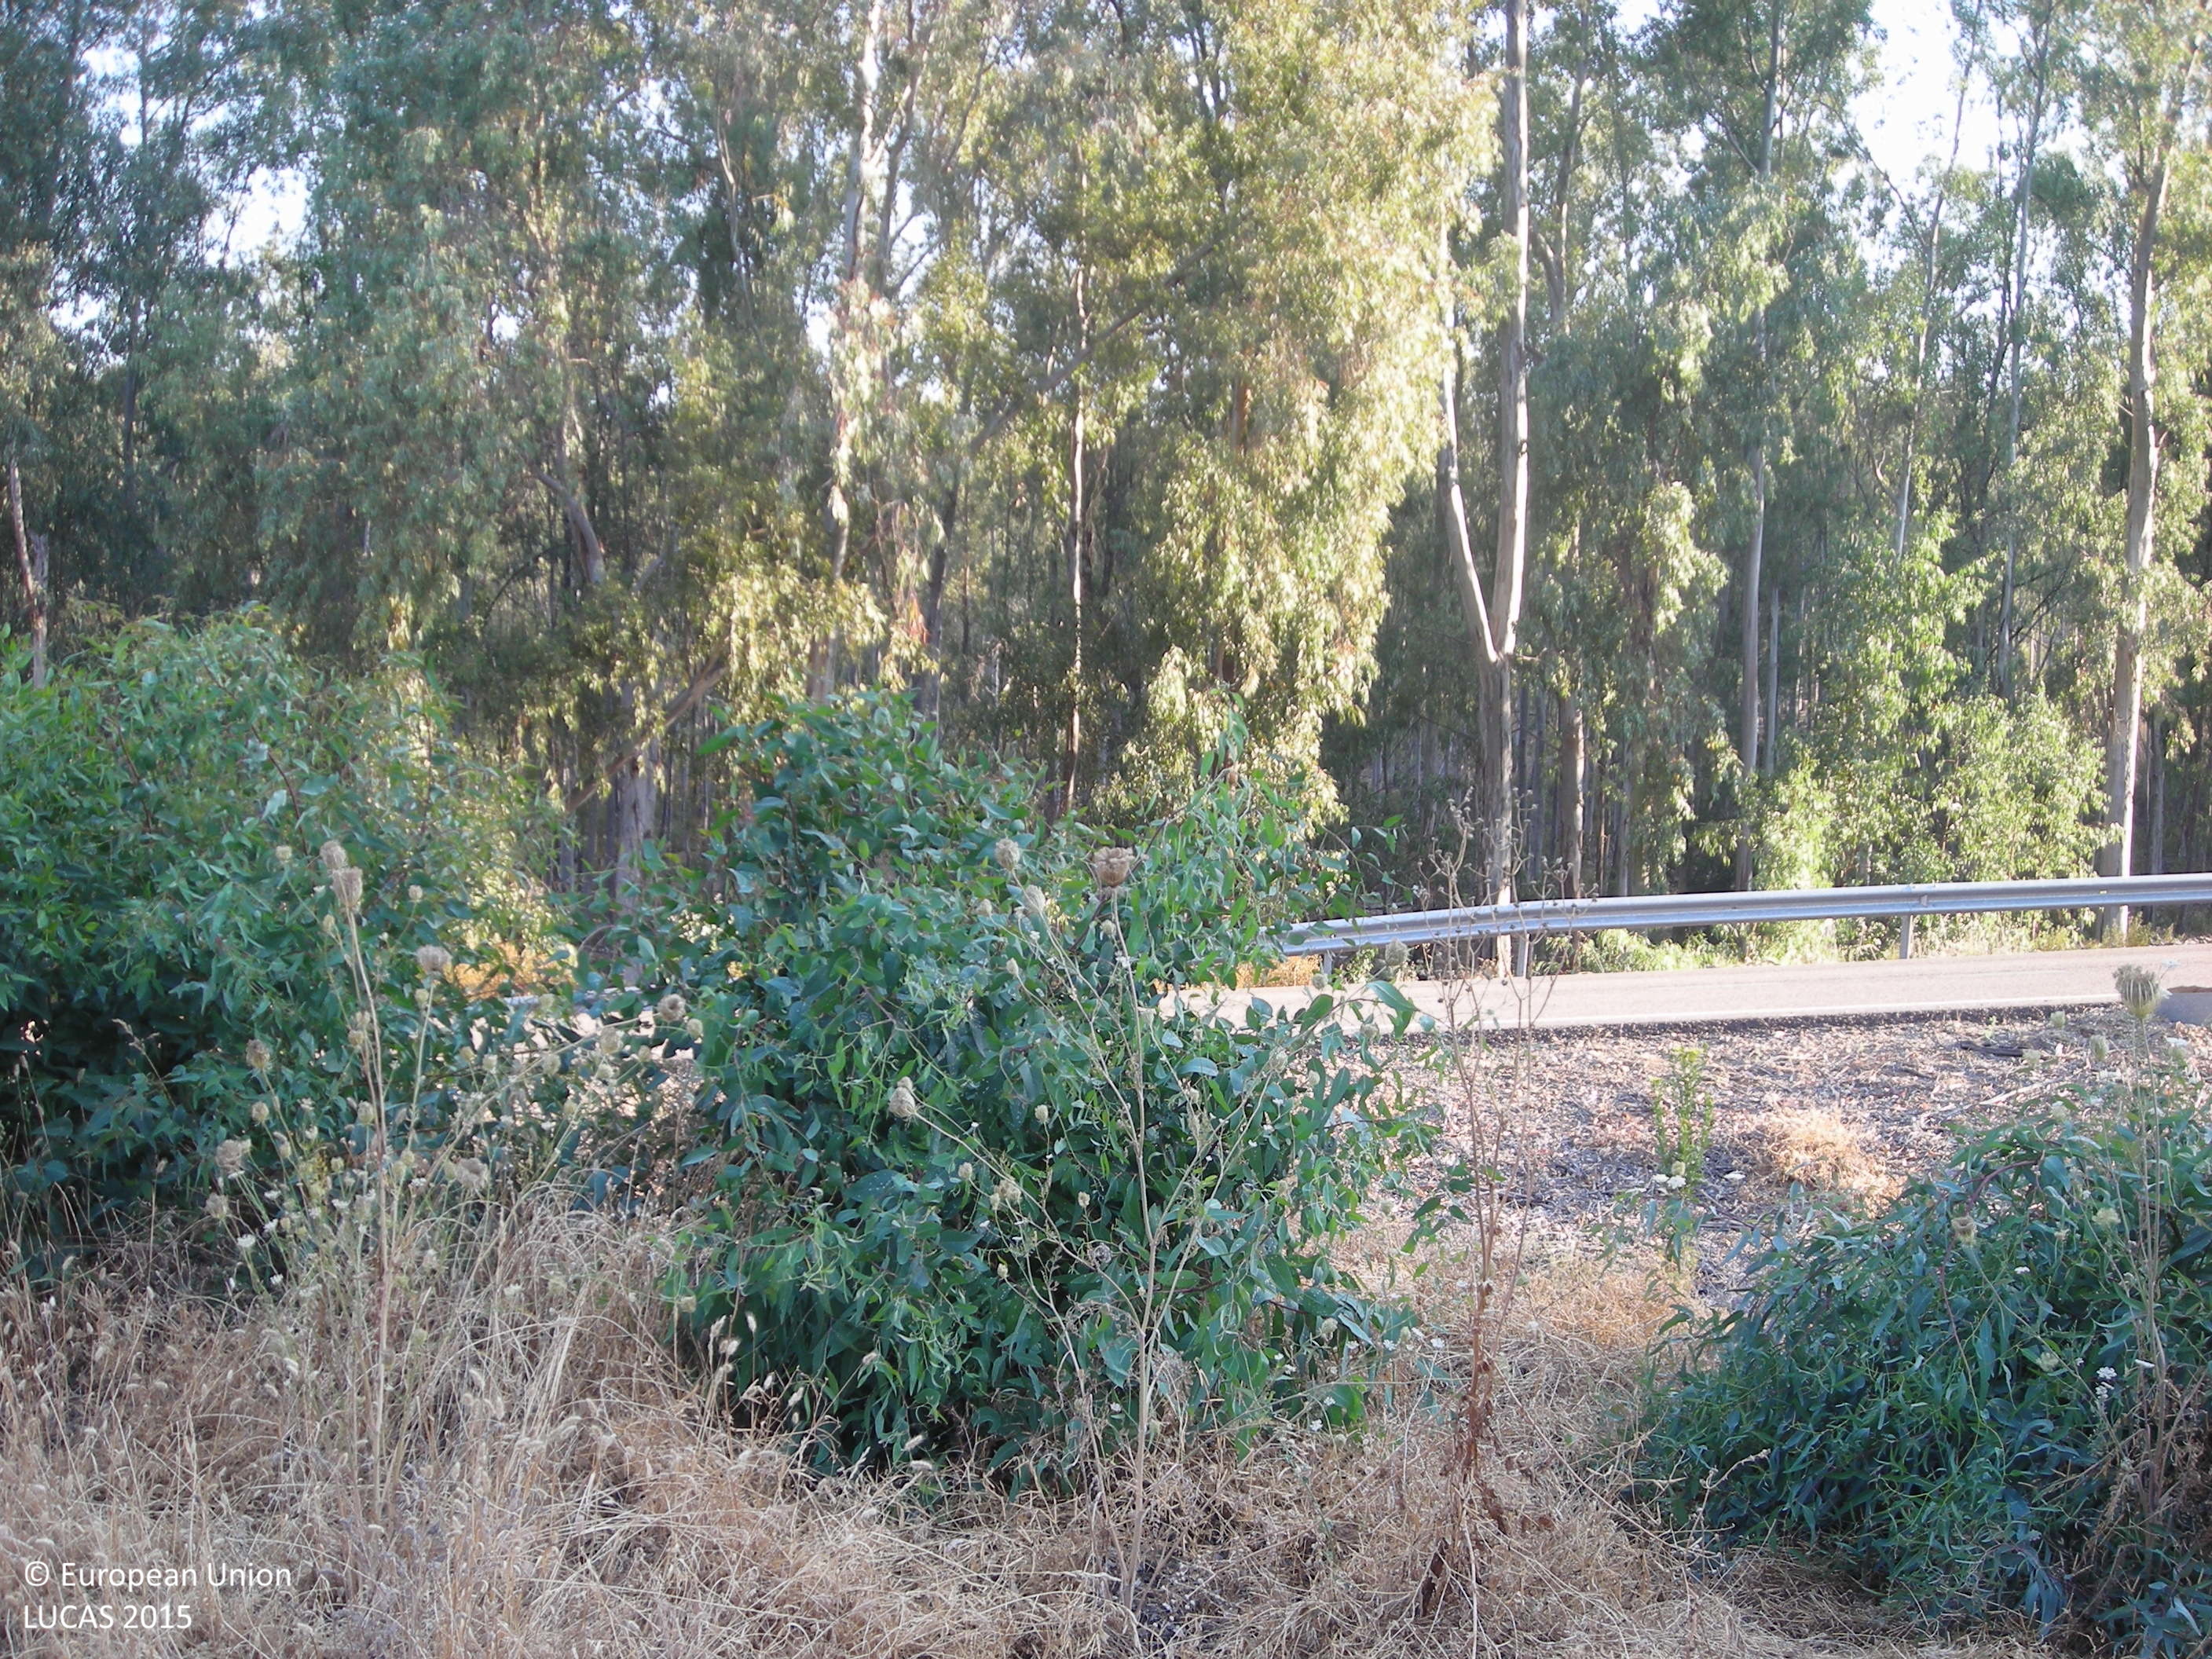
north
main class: Woodland
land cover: Broadleaved woodland
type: exotic forest
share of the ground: > 75 %
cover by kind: broadleaved forest trees 100 %
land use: Forestry
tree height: > 5 m
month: June
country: ES
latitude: 39.0504
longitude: -5.4699
